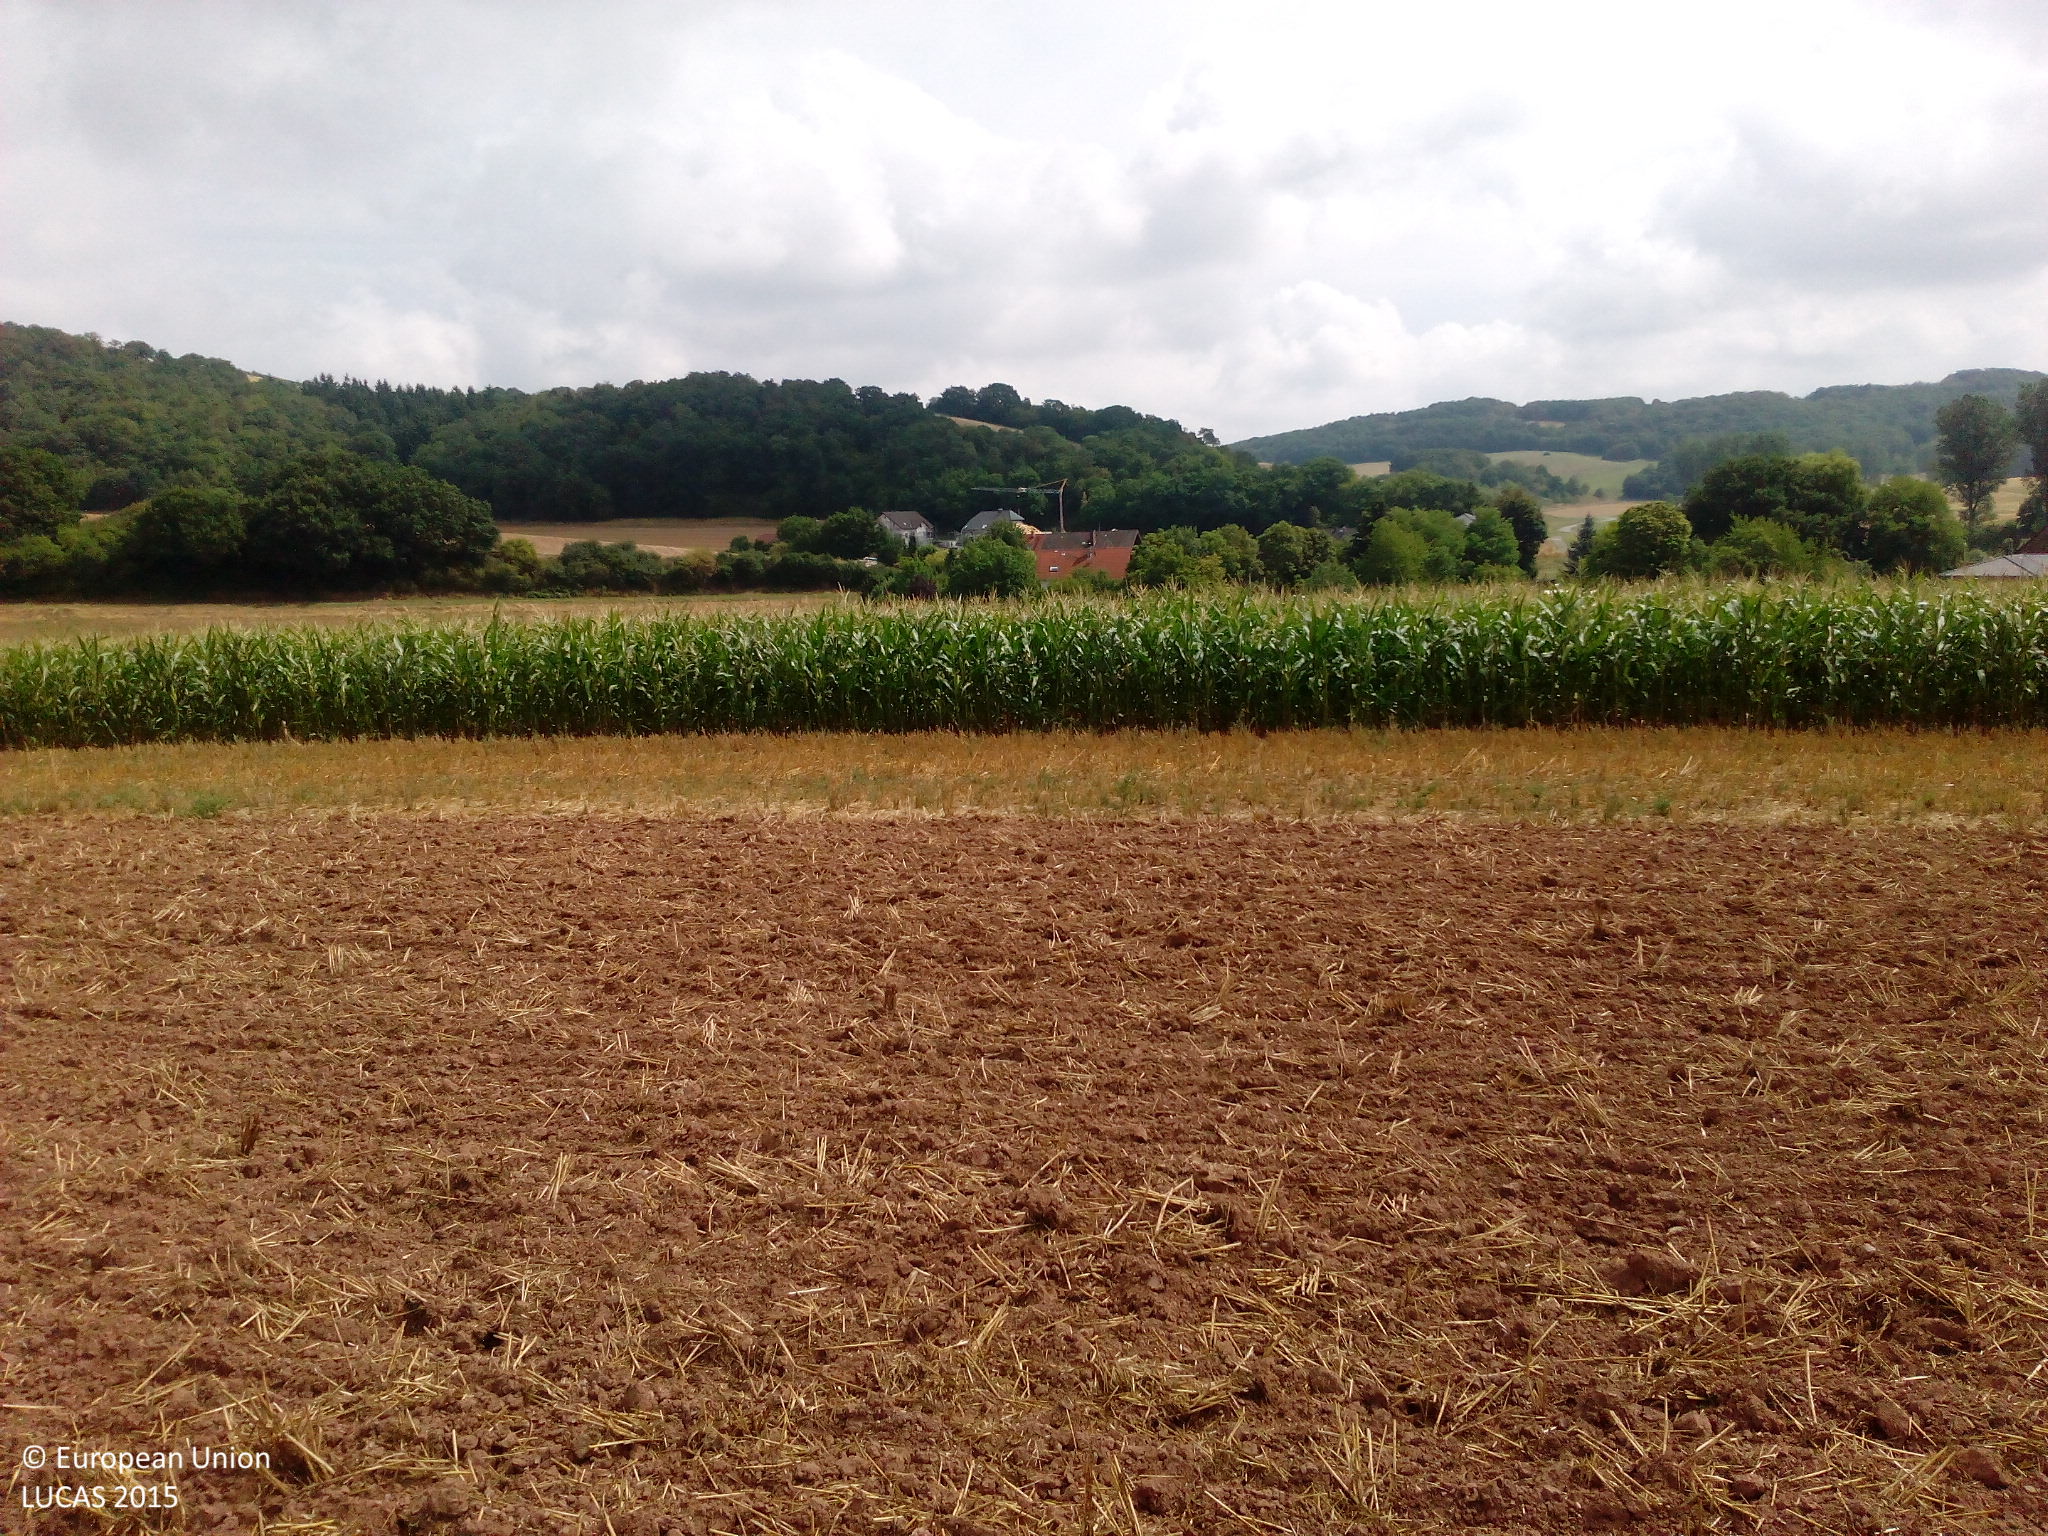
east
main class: Cropland
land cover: Common wheat
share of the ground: < 10 %
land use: Agriculture (excluding fallow land and kitchen gardens)
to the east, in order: Common wheat; Oats; Maize; Rape and turnip rape; Artificial constructions in urban areas
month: August
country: DE
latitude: 49.7440
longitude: 7.5441
